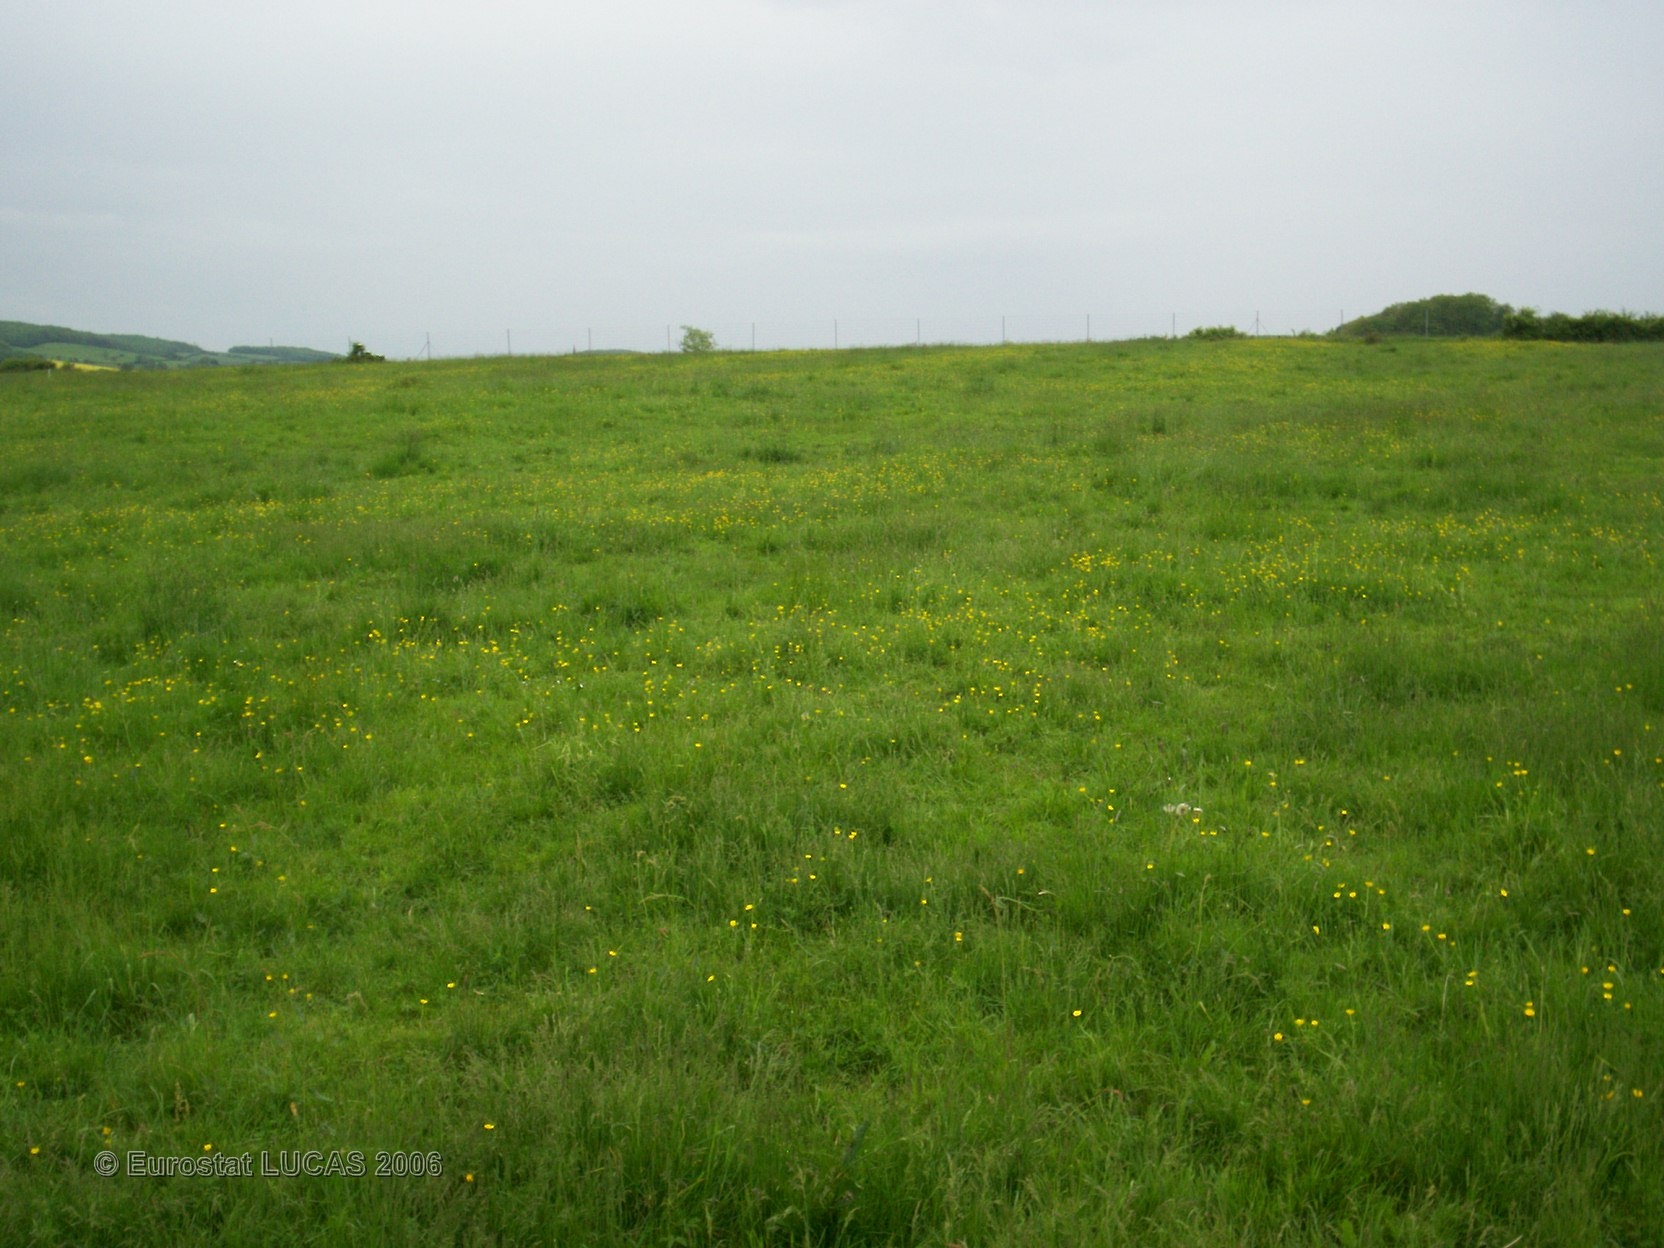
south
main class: Grassland
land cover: Grassland without tree/shrub cover
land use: Agriculture (excluding fallow land and kitchen gardens)
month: May
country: FR
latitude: 47.2087
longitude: 4.6265
